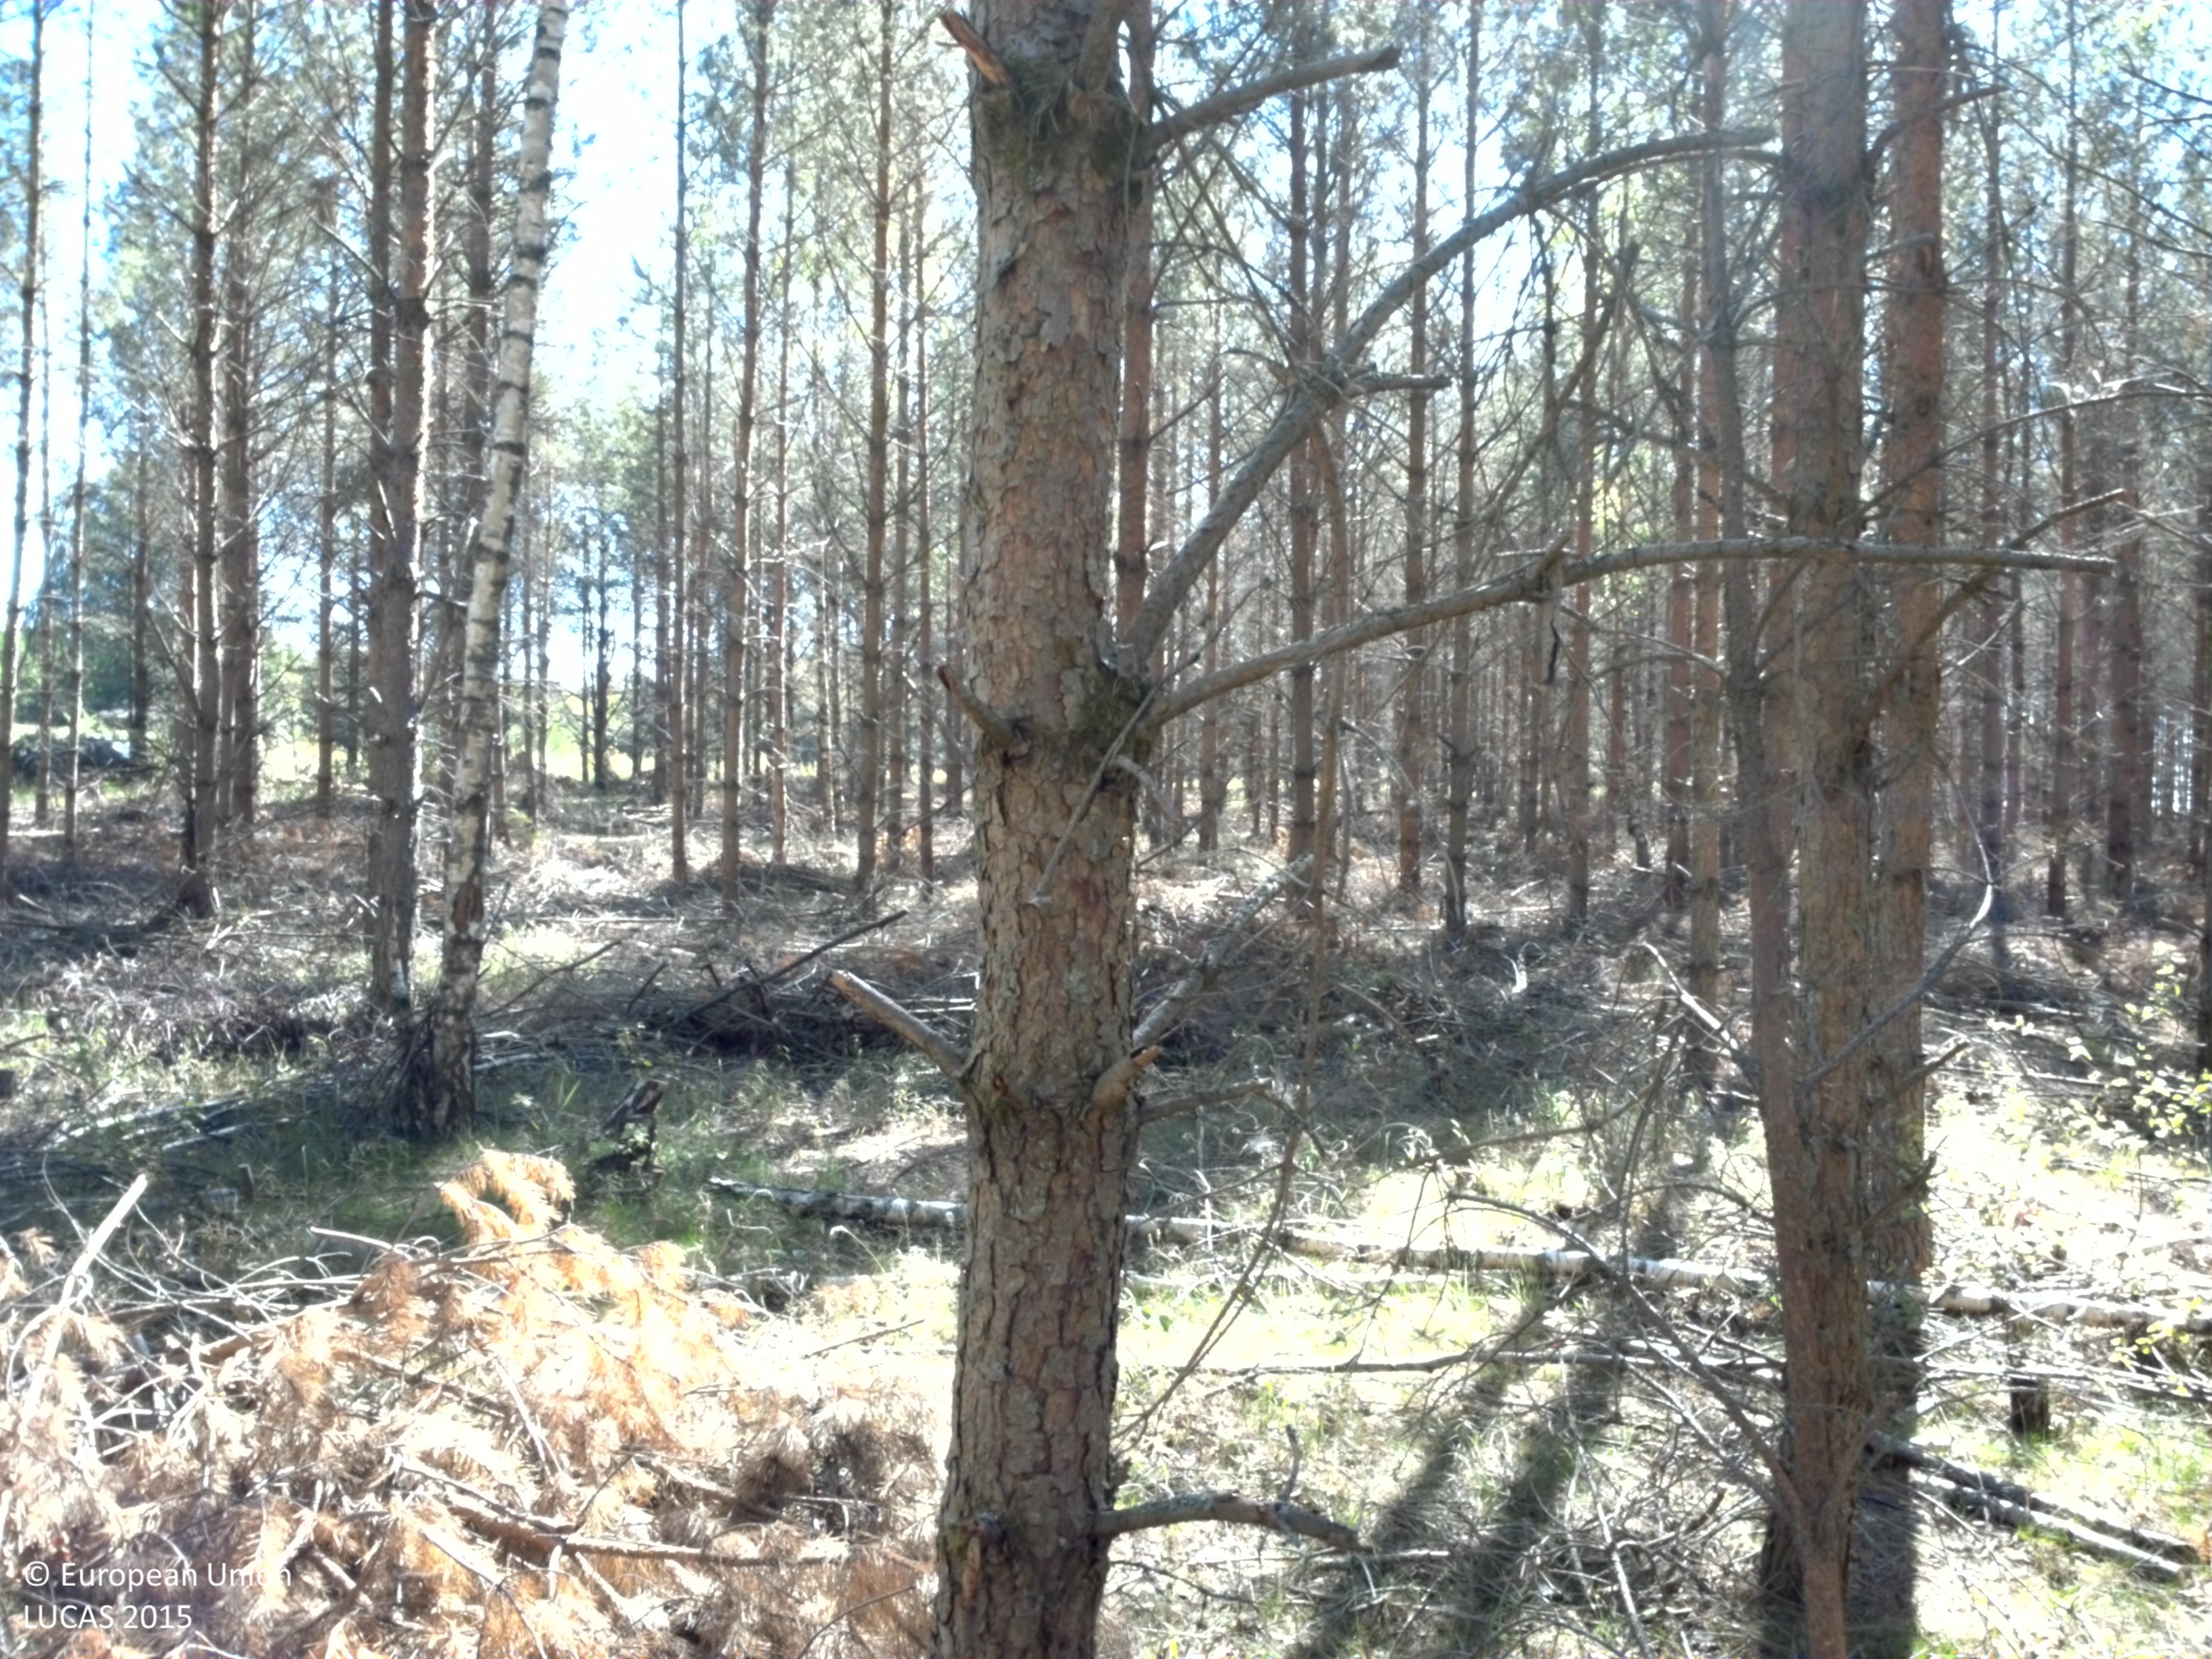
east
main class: Woodland
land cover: Pine dominated coniferous woodland
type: boreal forest
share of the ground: 25 - 50 %
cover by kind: coniferous forest trees 50 %, herbaceous plants 20 %, unconsolidated bare surface 10 %
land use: Community services
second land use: Forestry
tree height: > 5 m
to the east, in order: Pine dominated coniferous woodland; Tracks; Pine dominated coniferous woodland; Groves; Tracks; Spontaneously vegetated surfaces; Groves; Pine dominated mixed woodland; Broadleaved woodland; Dry stone walls; Broadleaved woodland; Pine dominated coniferous woodland; Tracks; Pine dominated coniferous woodland; Tracks; Pine dominated coniferous woodland
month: June
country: SE
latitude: 58.5044
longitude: 14.5069
